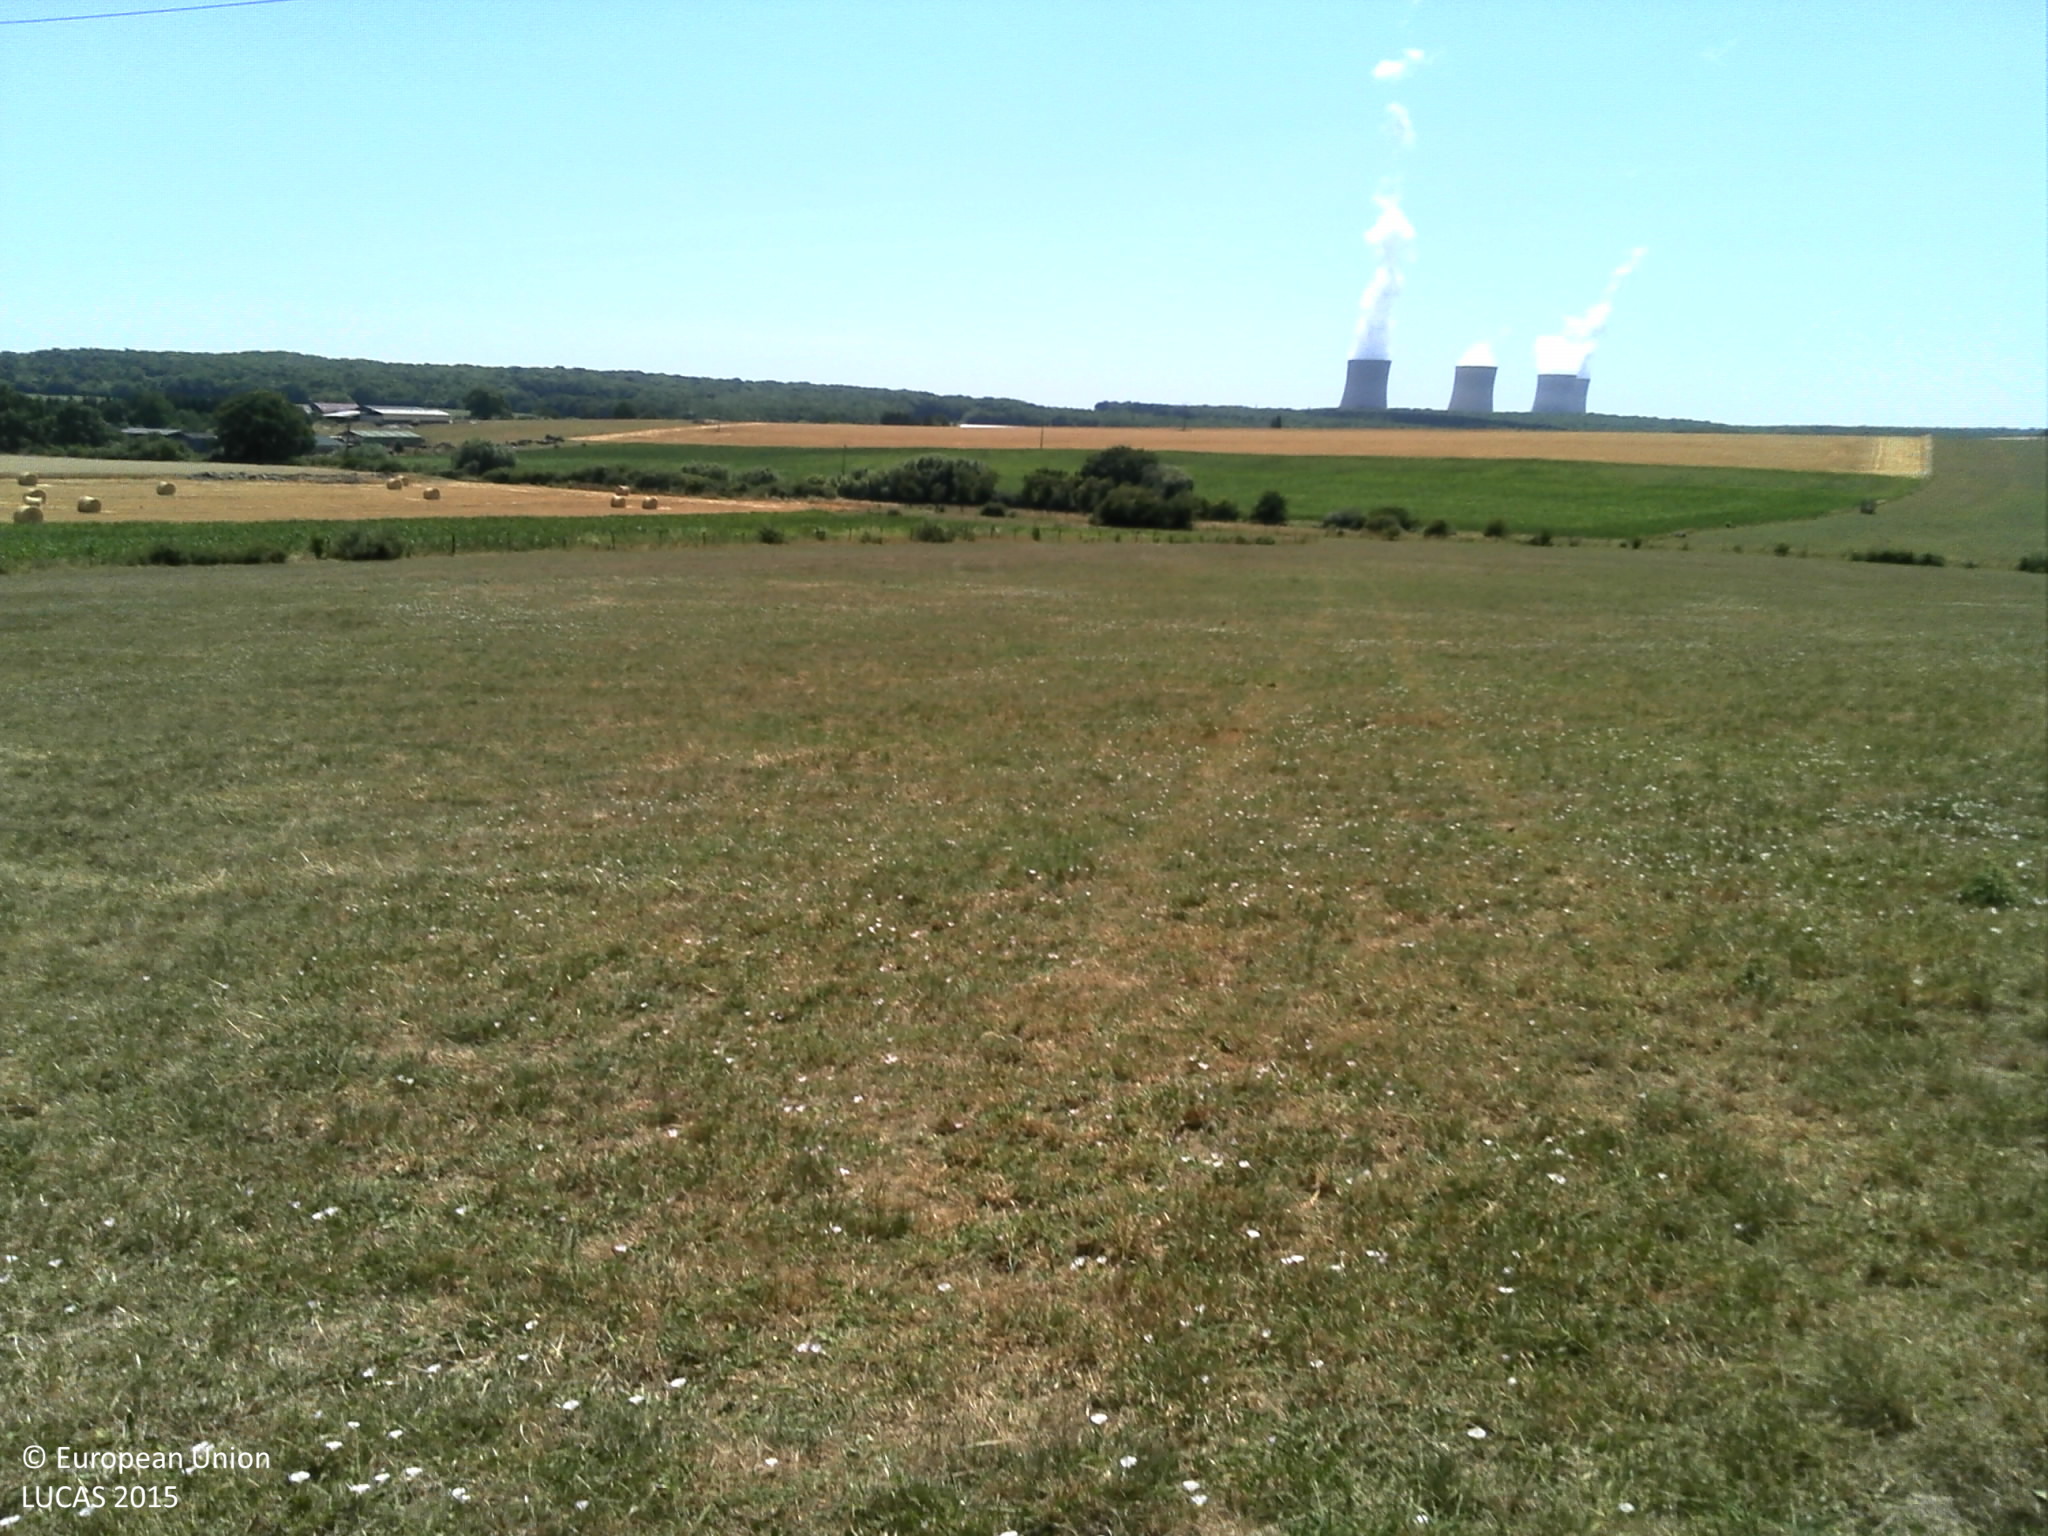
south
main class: Grassland
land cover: Grassland without tree/shrub cover
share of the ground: > 75 %
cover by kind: herbaceous plants 100 %
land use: Agriculture (excluding fallow land and kitchen gardens)
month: July
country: FR
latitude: 49.4559
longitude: 6.2334
